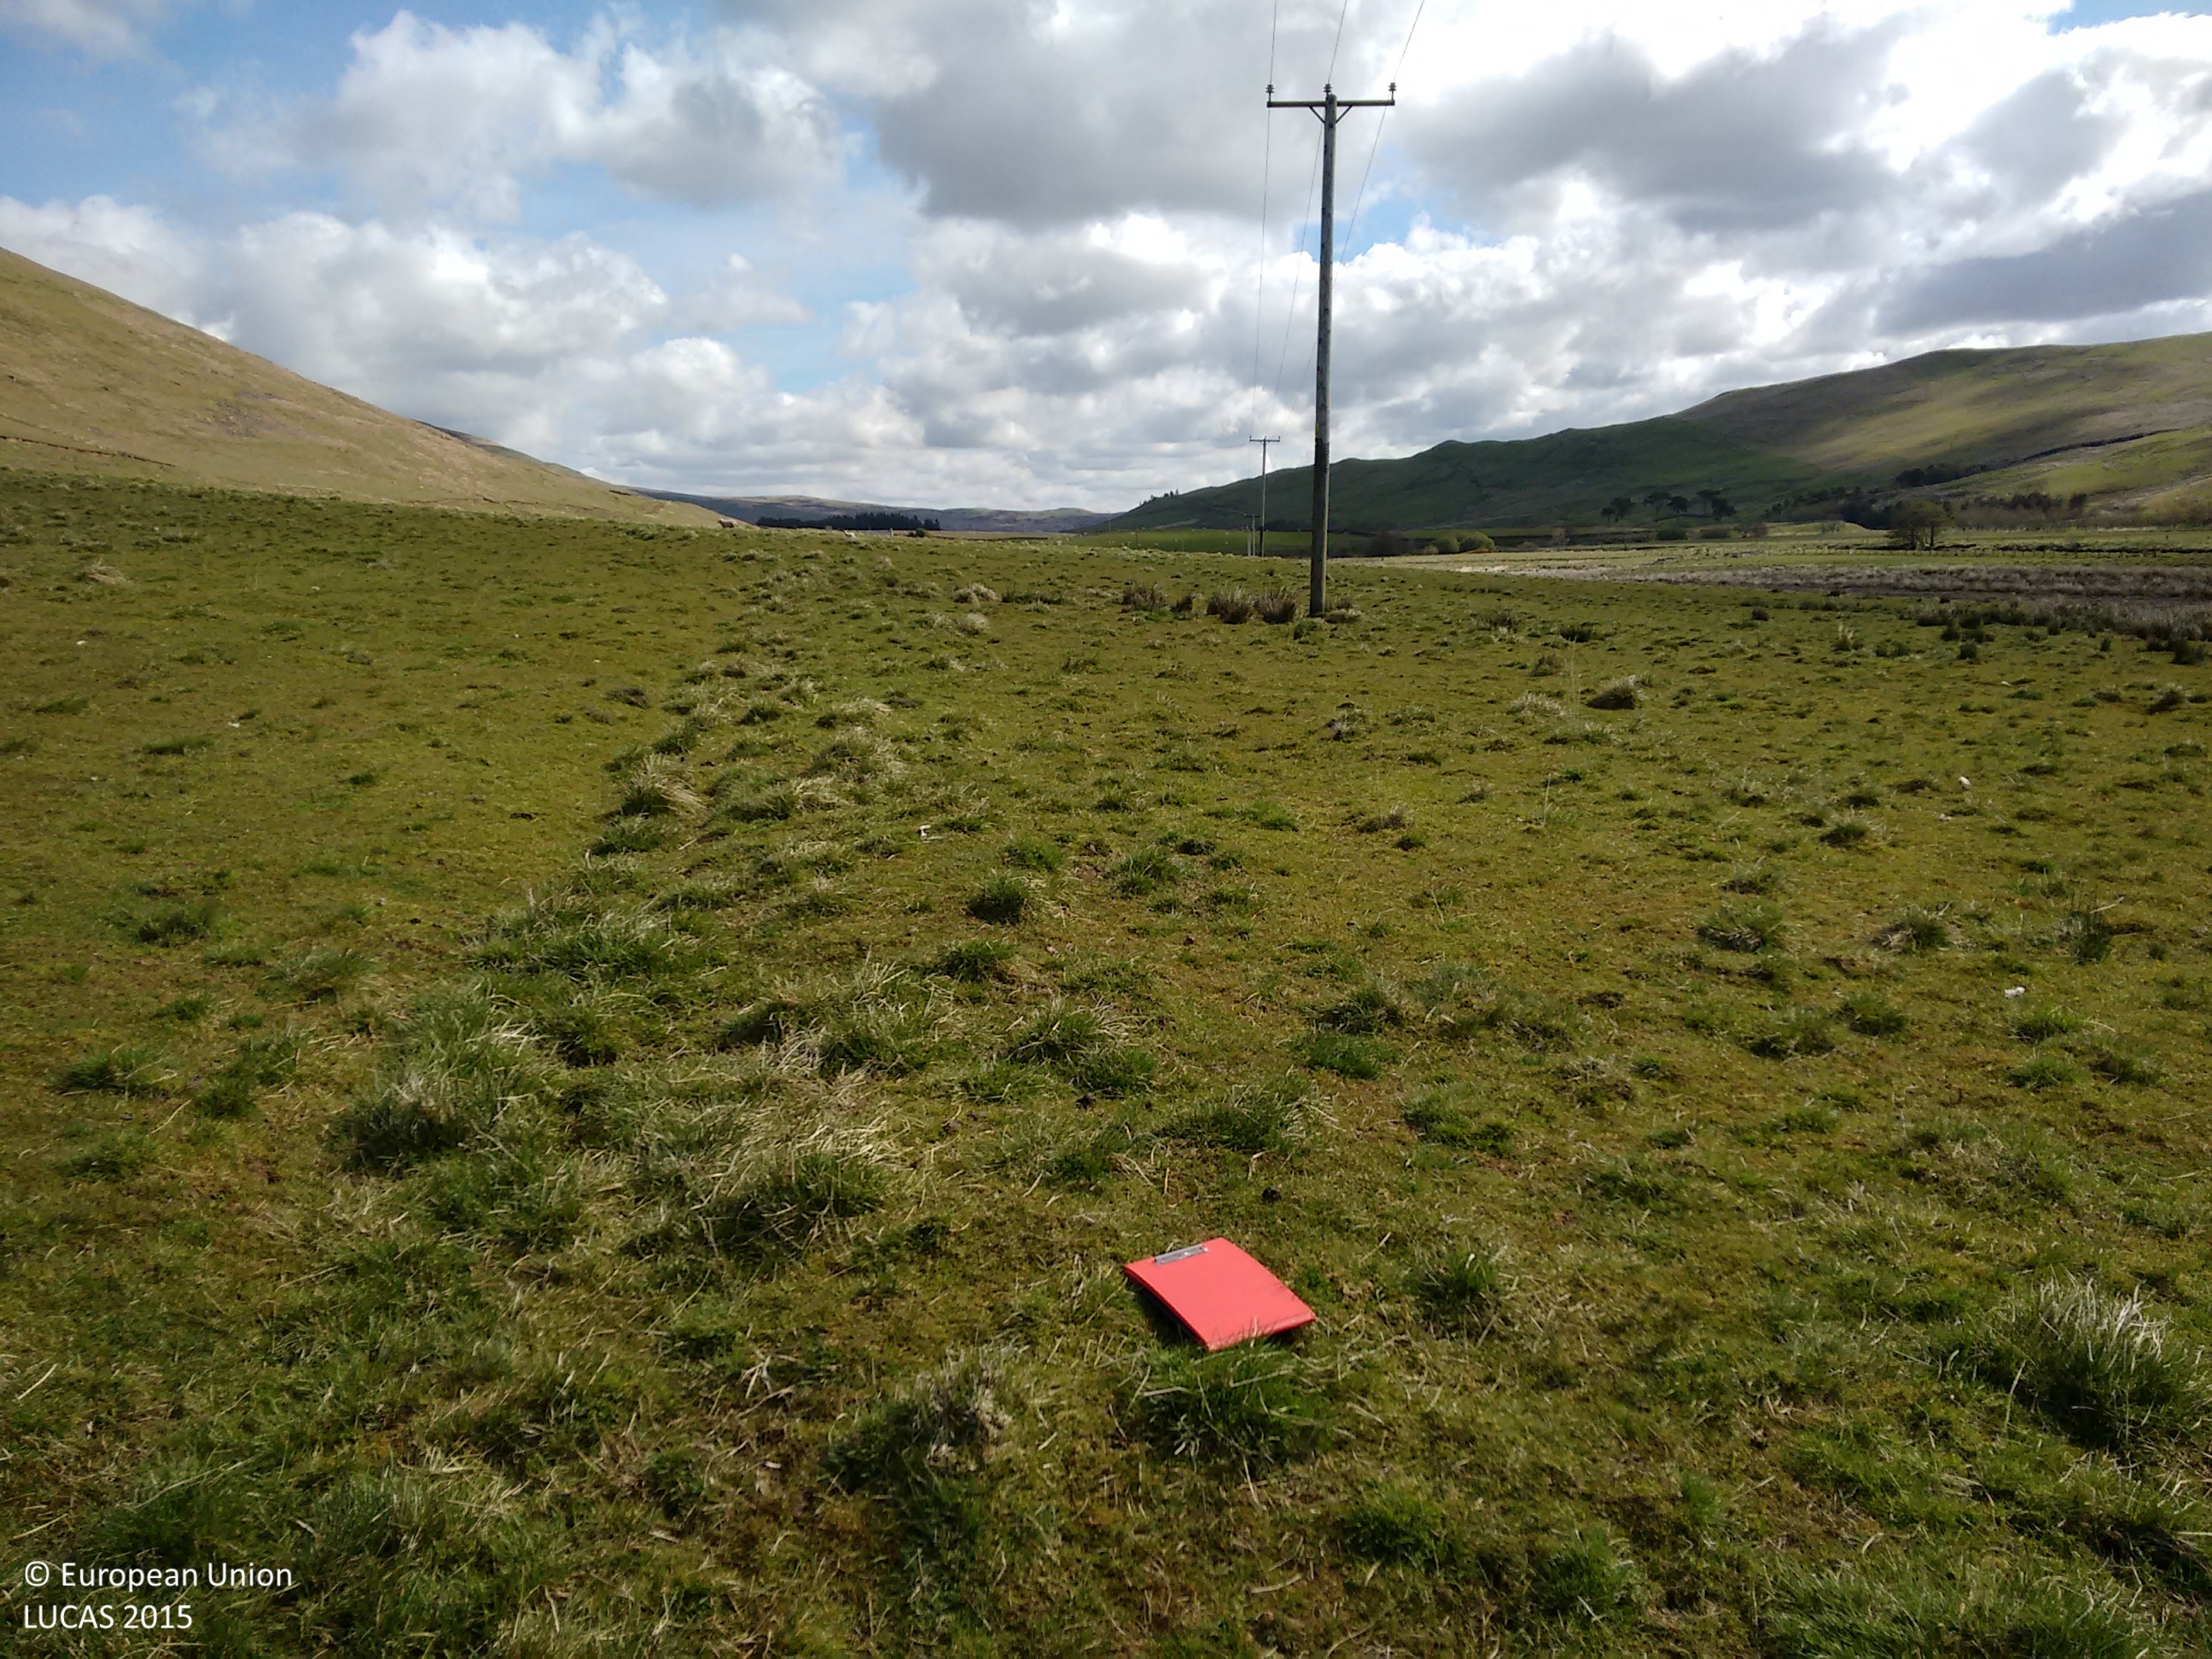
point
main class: Grassland
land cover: Grassland without tree/shrub cover
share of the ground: > 75 %
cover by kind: herbaceous plants 95 %, shrubs 5 %
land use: Agriculture (excluding fallow land and kitchen gardens)
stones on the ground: < 10 %
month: May
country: GB
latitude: 55.4591
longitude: -3.0865
